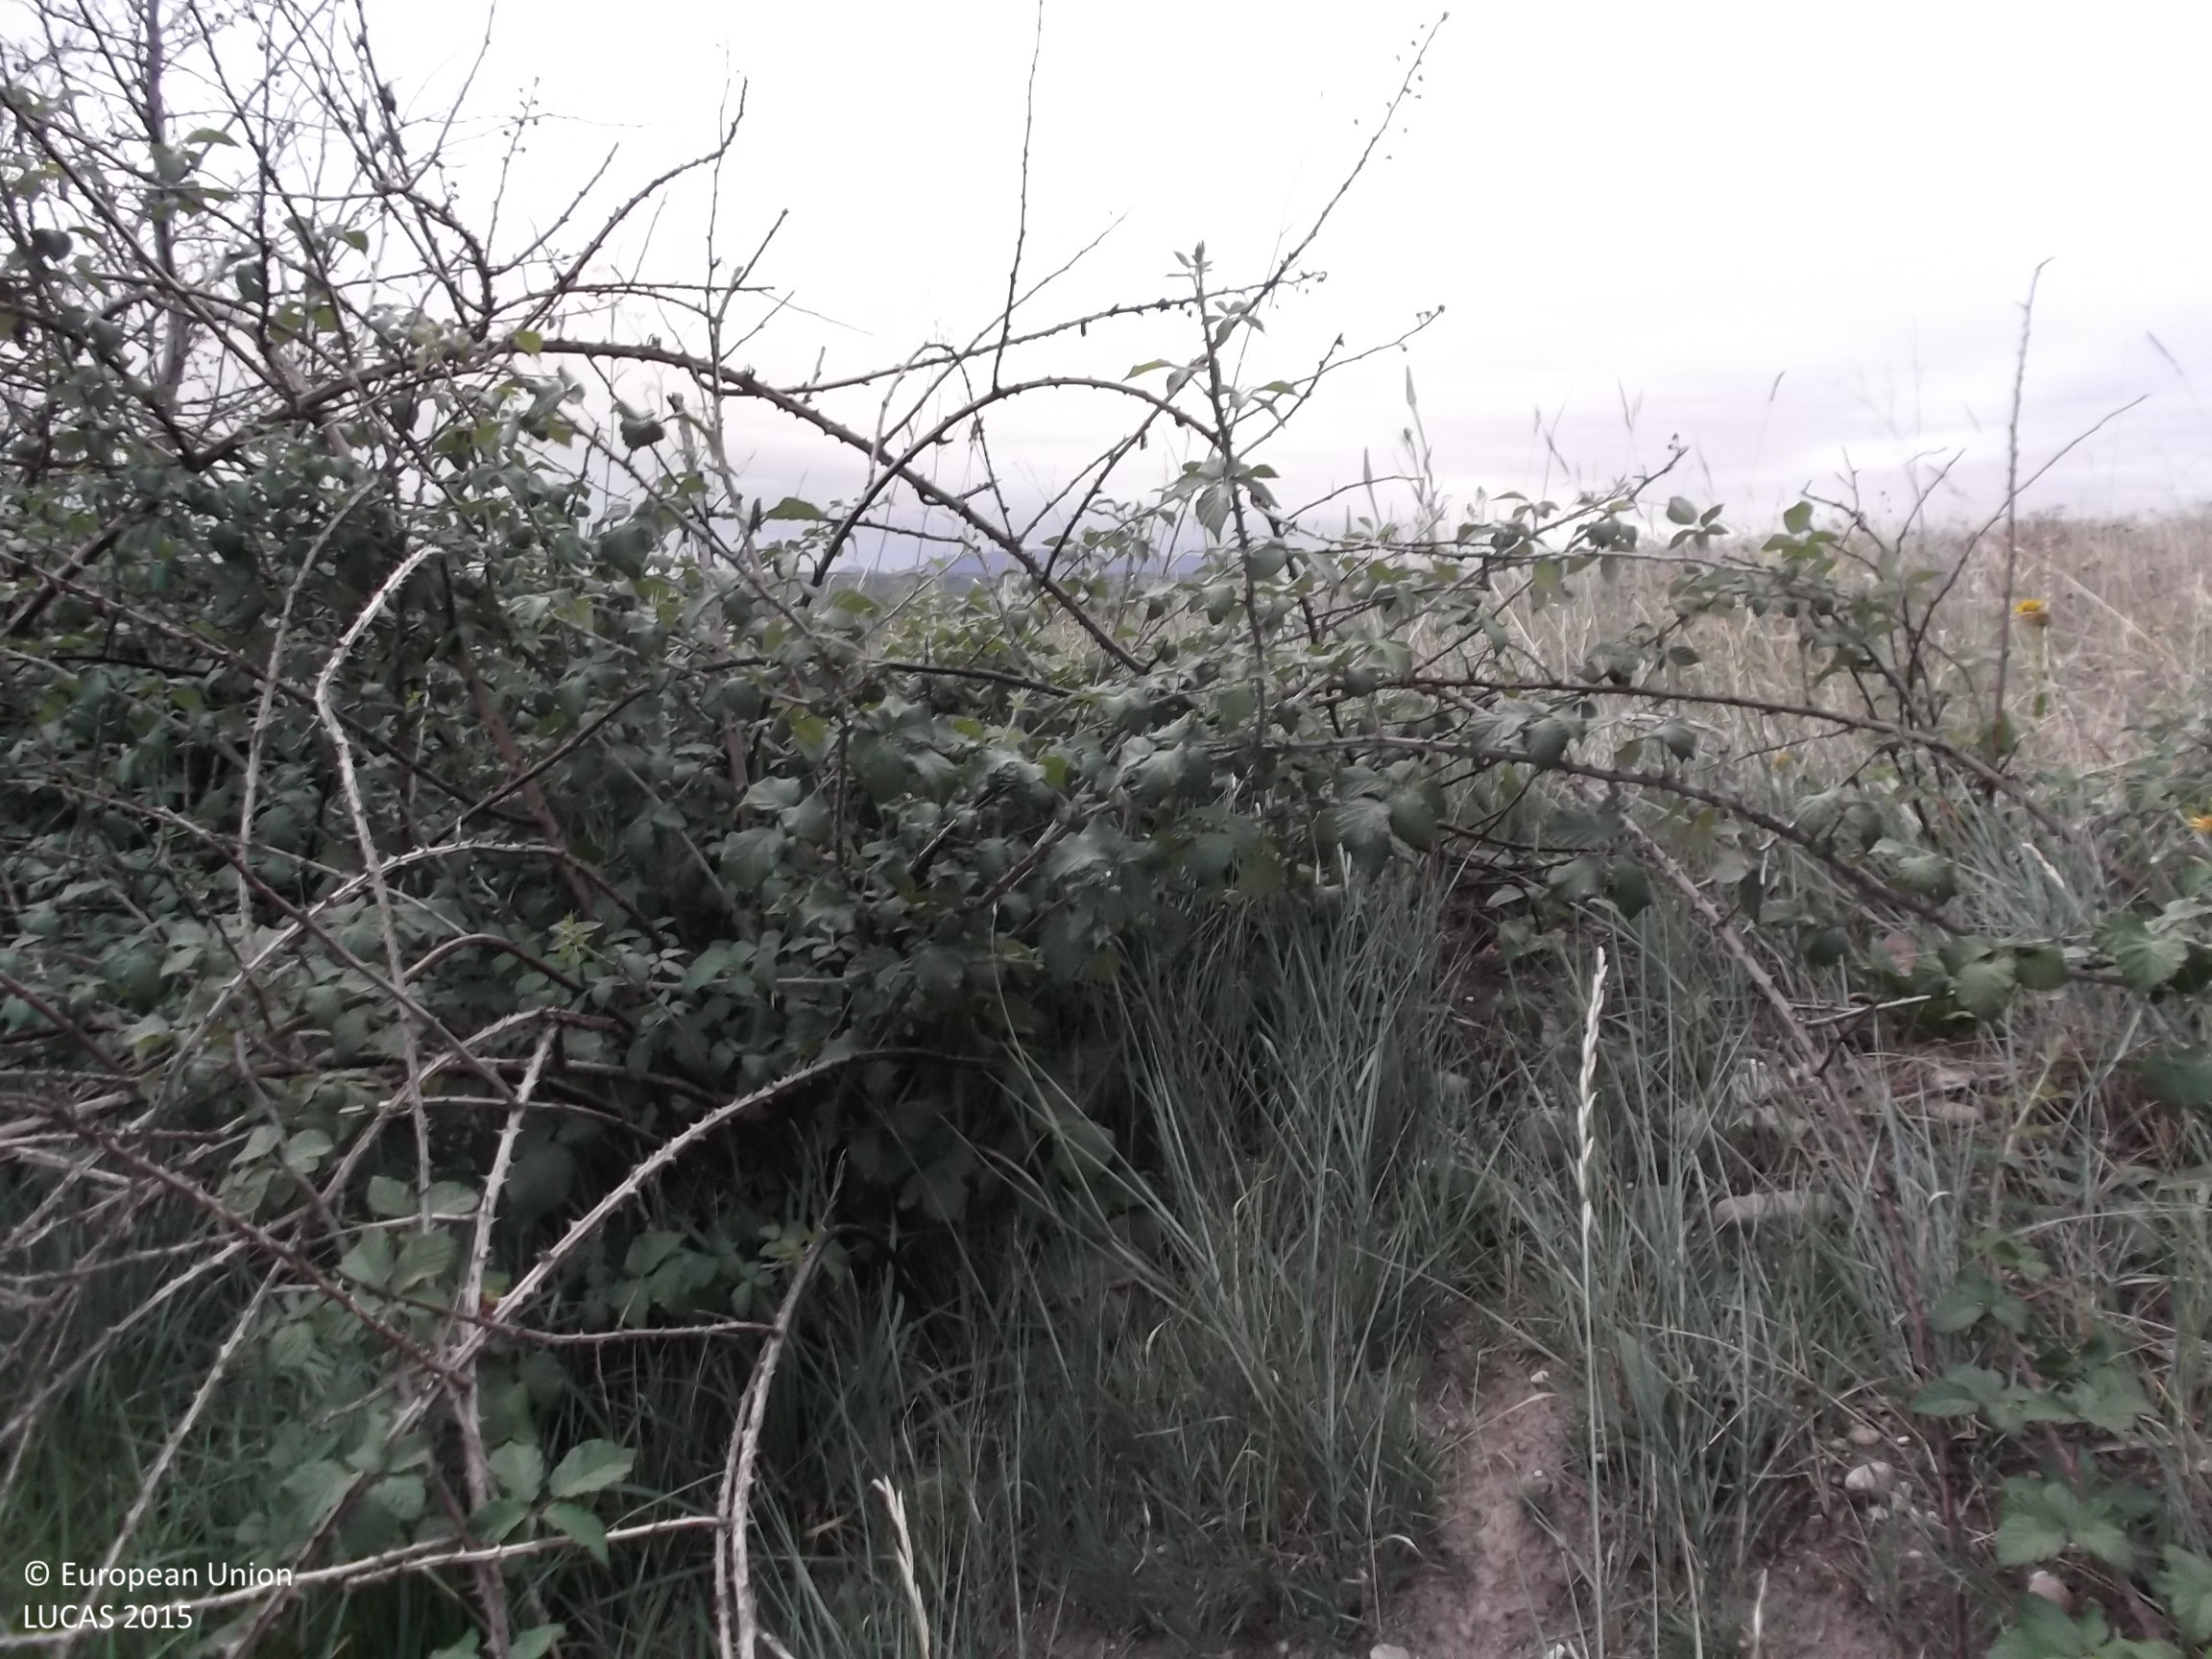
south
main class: Shrubland
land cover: Shrubland without tree cover
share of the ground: 50 - 75 %
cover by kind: shrubs 50 %, herbaceous plants 50 %
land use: Semi-natural and natural areas not in use
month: July
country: ES
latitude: 42.4770
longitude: -2.3662
